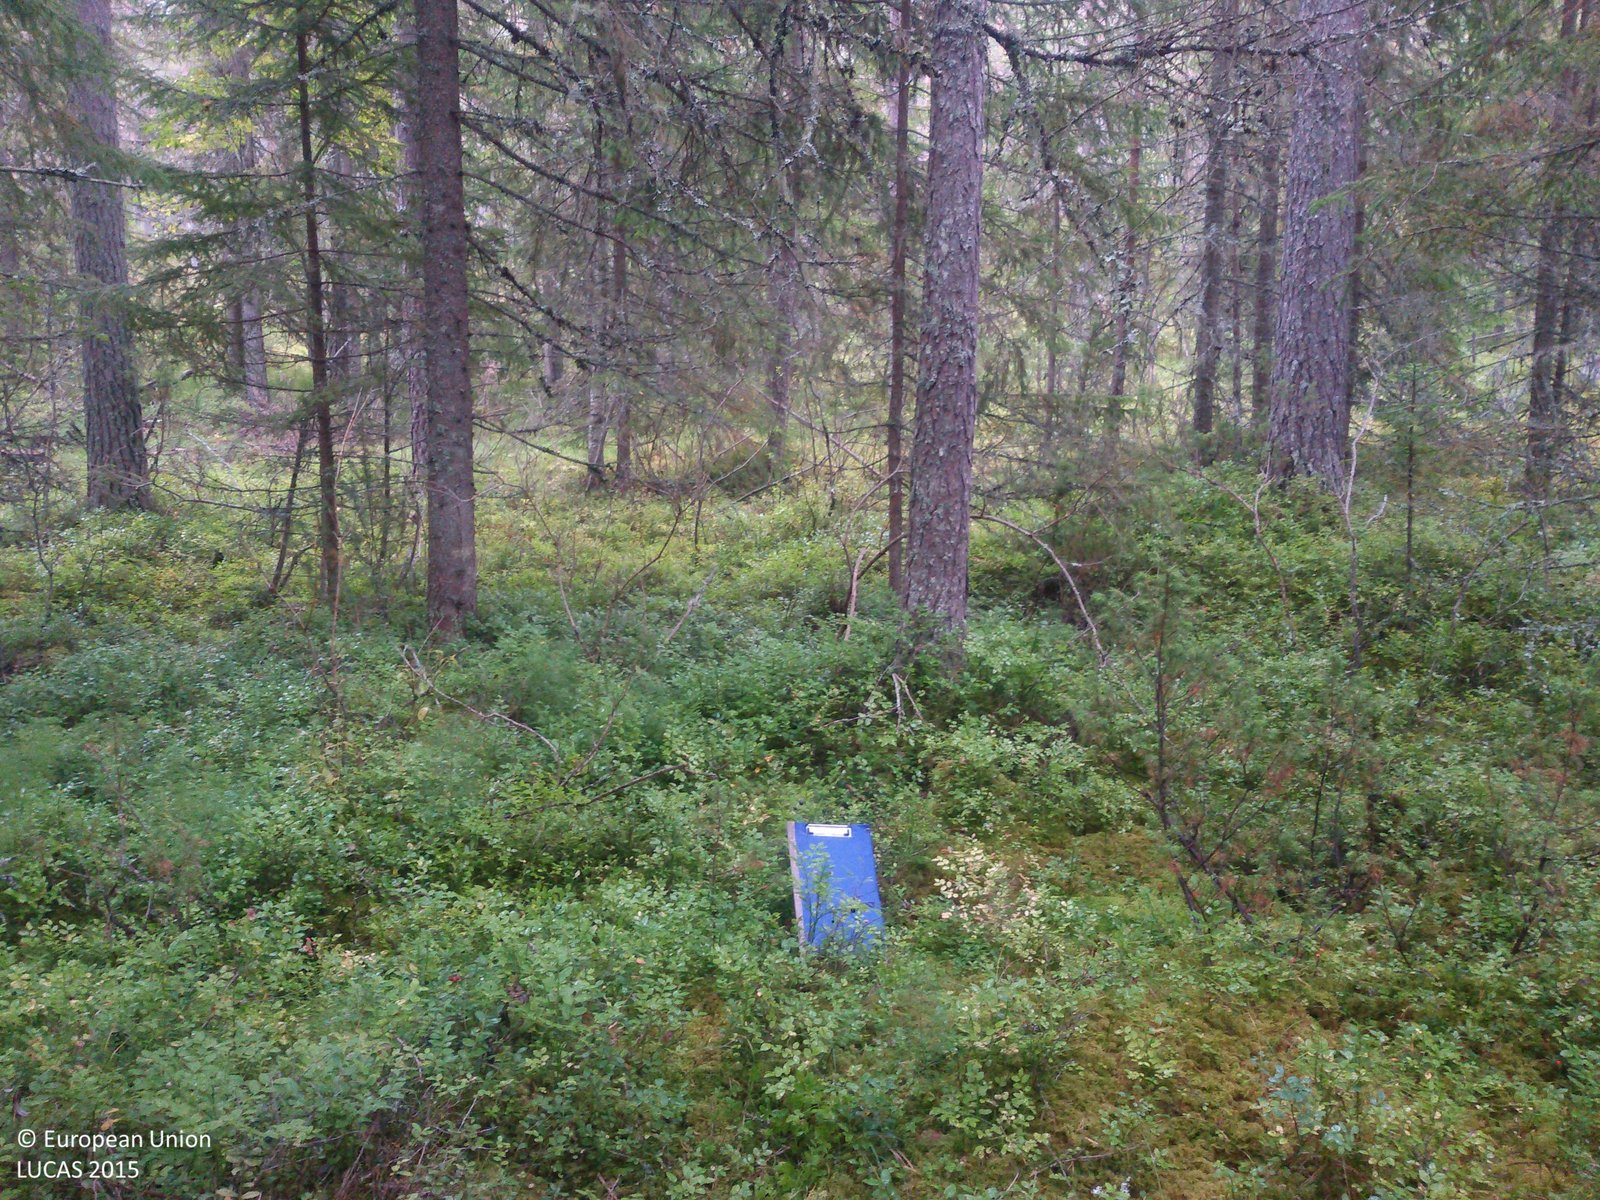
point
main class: Woodland
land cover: Other coniferous woodland
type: boreal forest
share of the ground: 50 - 75 %
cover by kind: coniferous forest trees 70 %, herbaceous plants 20 %, lichens and mosses 10 %
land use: Forestry
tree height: > 5 m
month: September
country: SE
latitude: 61.0910
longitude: 14.2334
